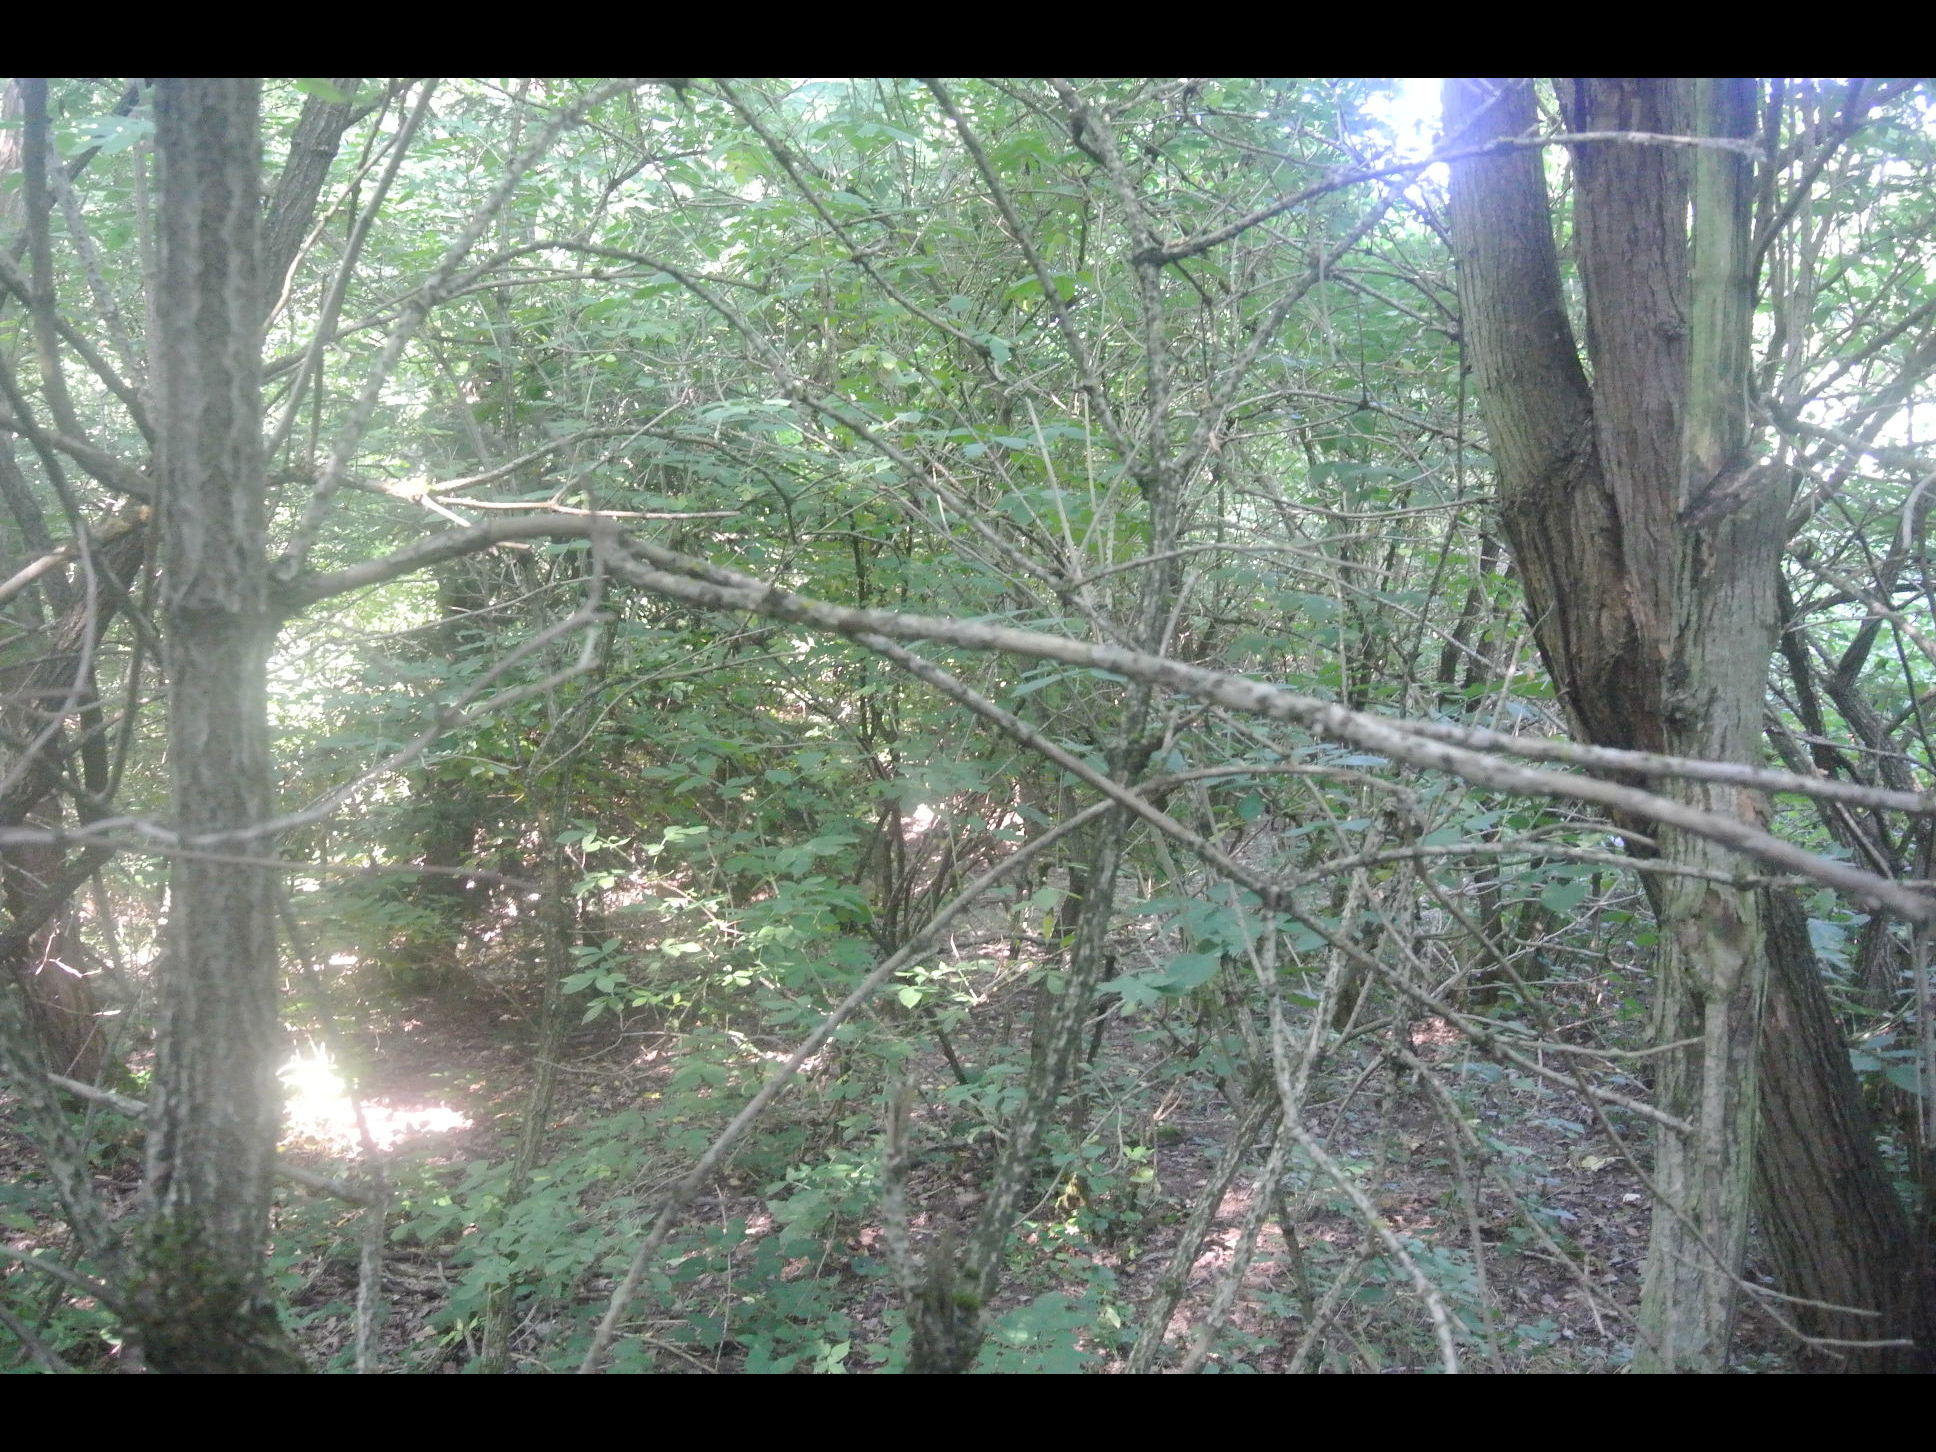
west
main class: Woodland
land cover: Broadleaved woodland
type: exotic forest
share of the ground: > 75 %
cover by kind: broadleaved forest trees 100 %
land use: Forestry
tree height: > 5 m
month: July
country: AT
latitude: 47.5652
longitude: 16.4502
